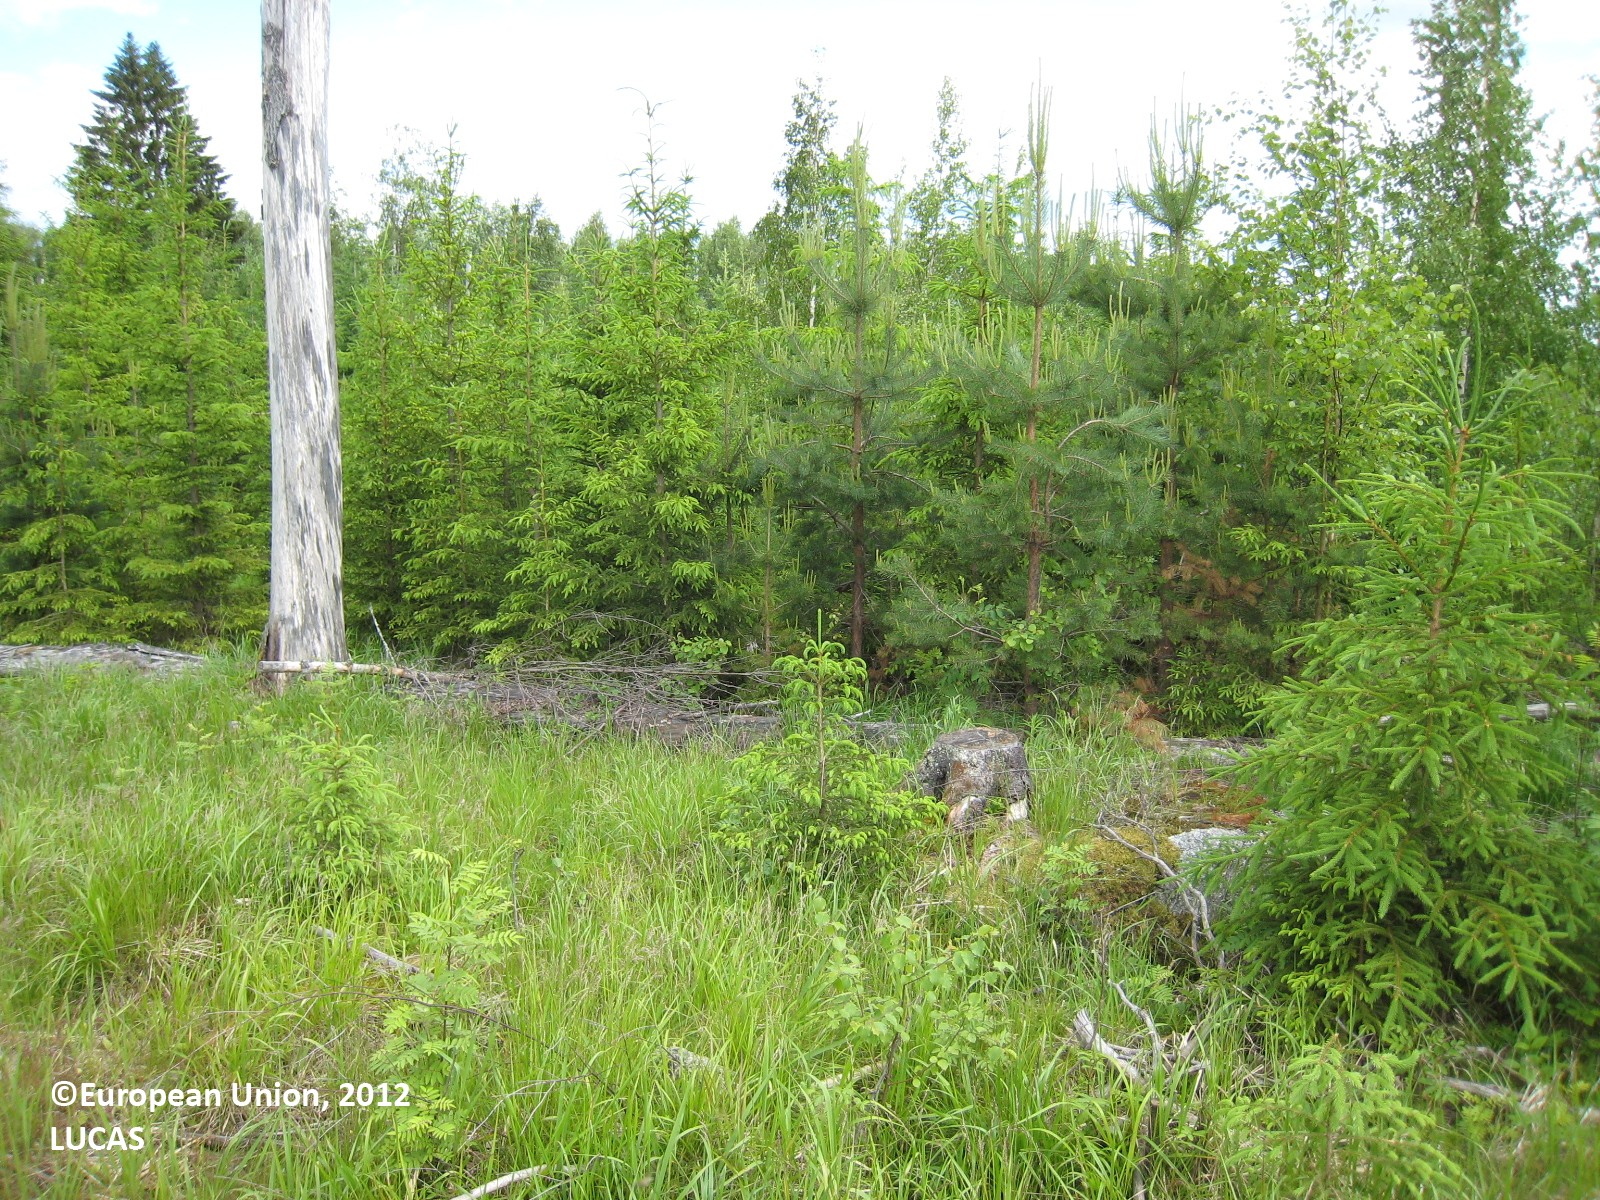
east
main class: Grassland
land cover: Grassland with sparse tree/shrub cover
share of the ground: > 75 %
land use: Forestry
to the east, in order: Grassland with sparse tree/shrub cover; Other coniferous woodland; Other mixed woodland; Broadleaved woodland; Shrubland with sparse tree cover; Electric lines; Spruce dominated mixed woodland; Ditches and canals; Grass margins; Paved roads, cycling and walking lanes; Shruby margins; Ditches and canals; Broadleaved woodland; Electric lines; Ditches and canals; Broadleaved woodland; Shrubland without tree cover; Grassland without tree/shrub cover; Artificial constructions in urban areas; Grassland with sparse tree/shrub cover; Artificial constructions in urban areas
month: June
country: FI
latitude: 62.1434
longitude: 26.2686
